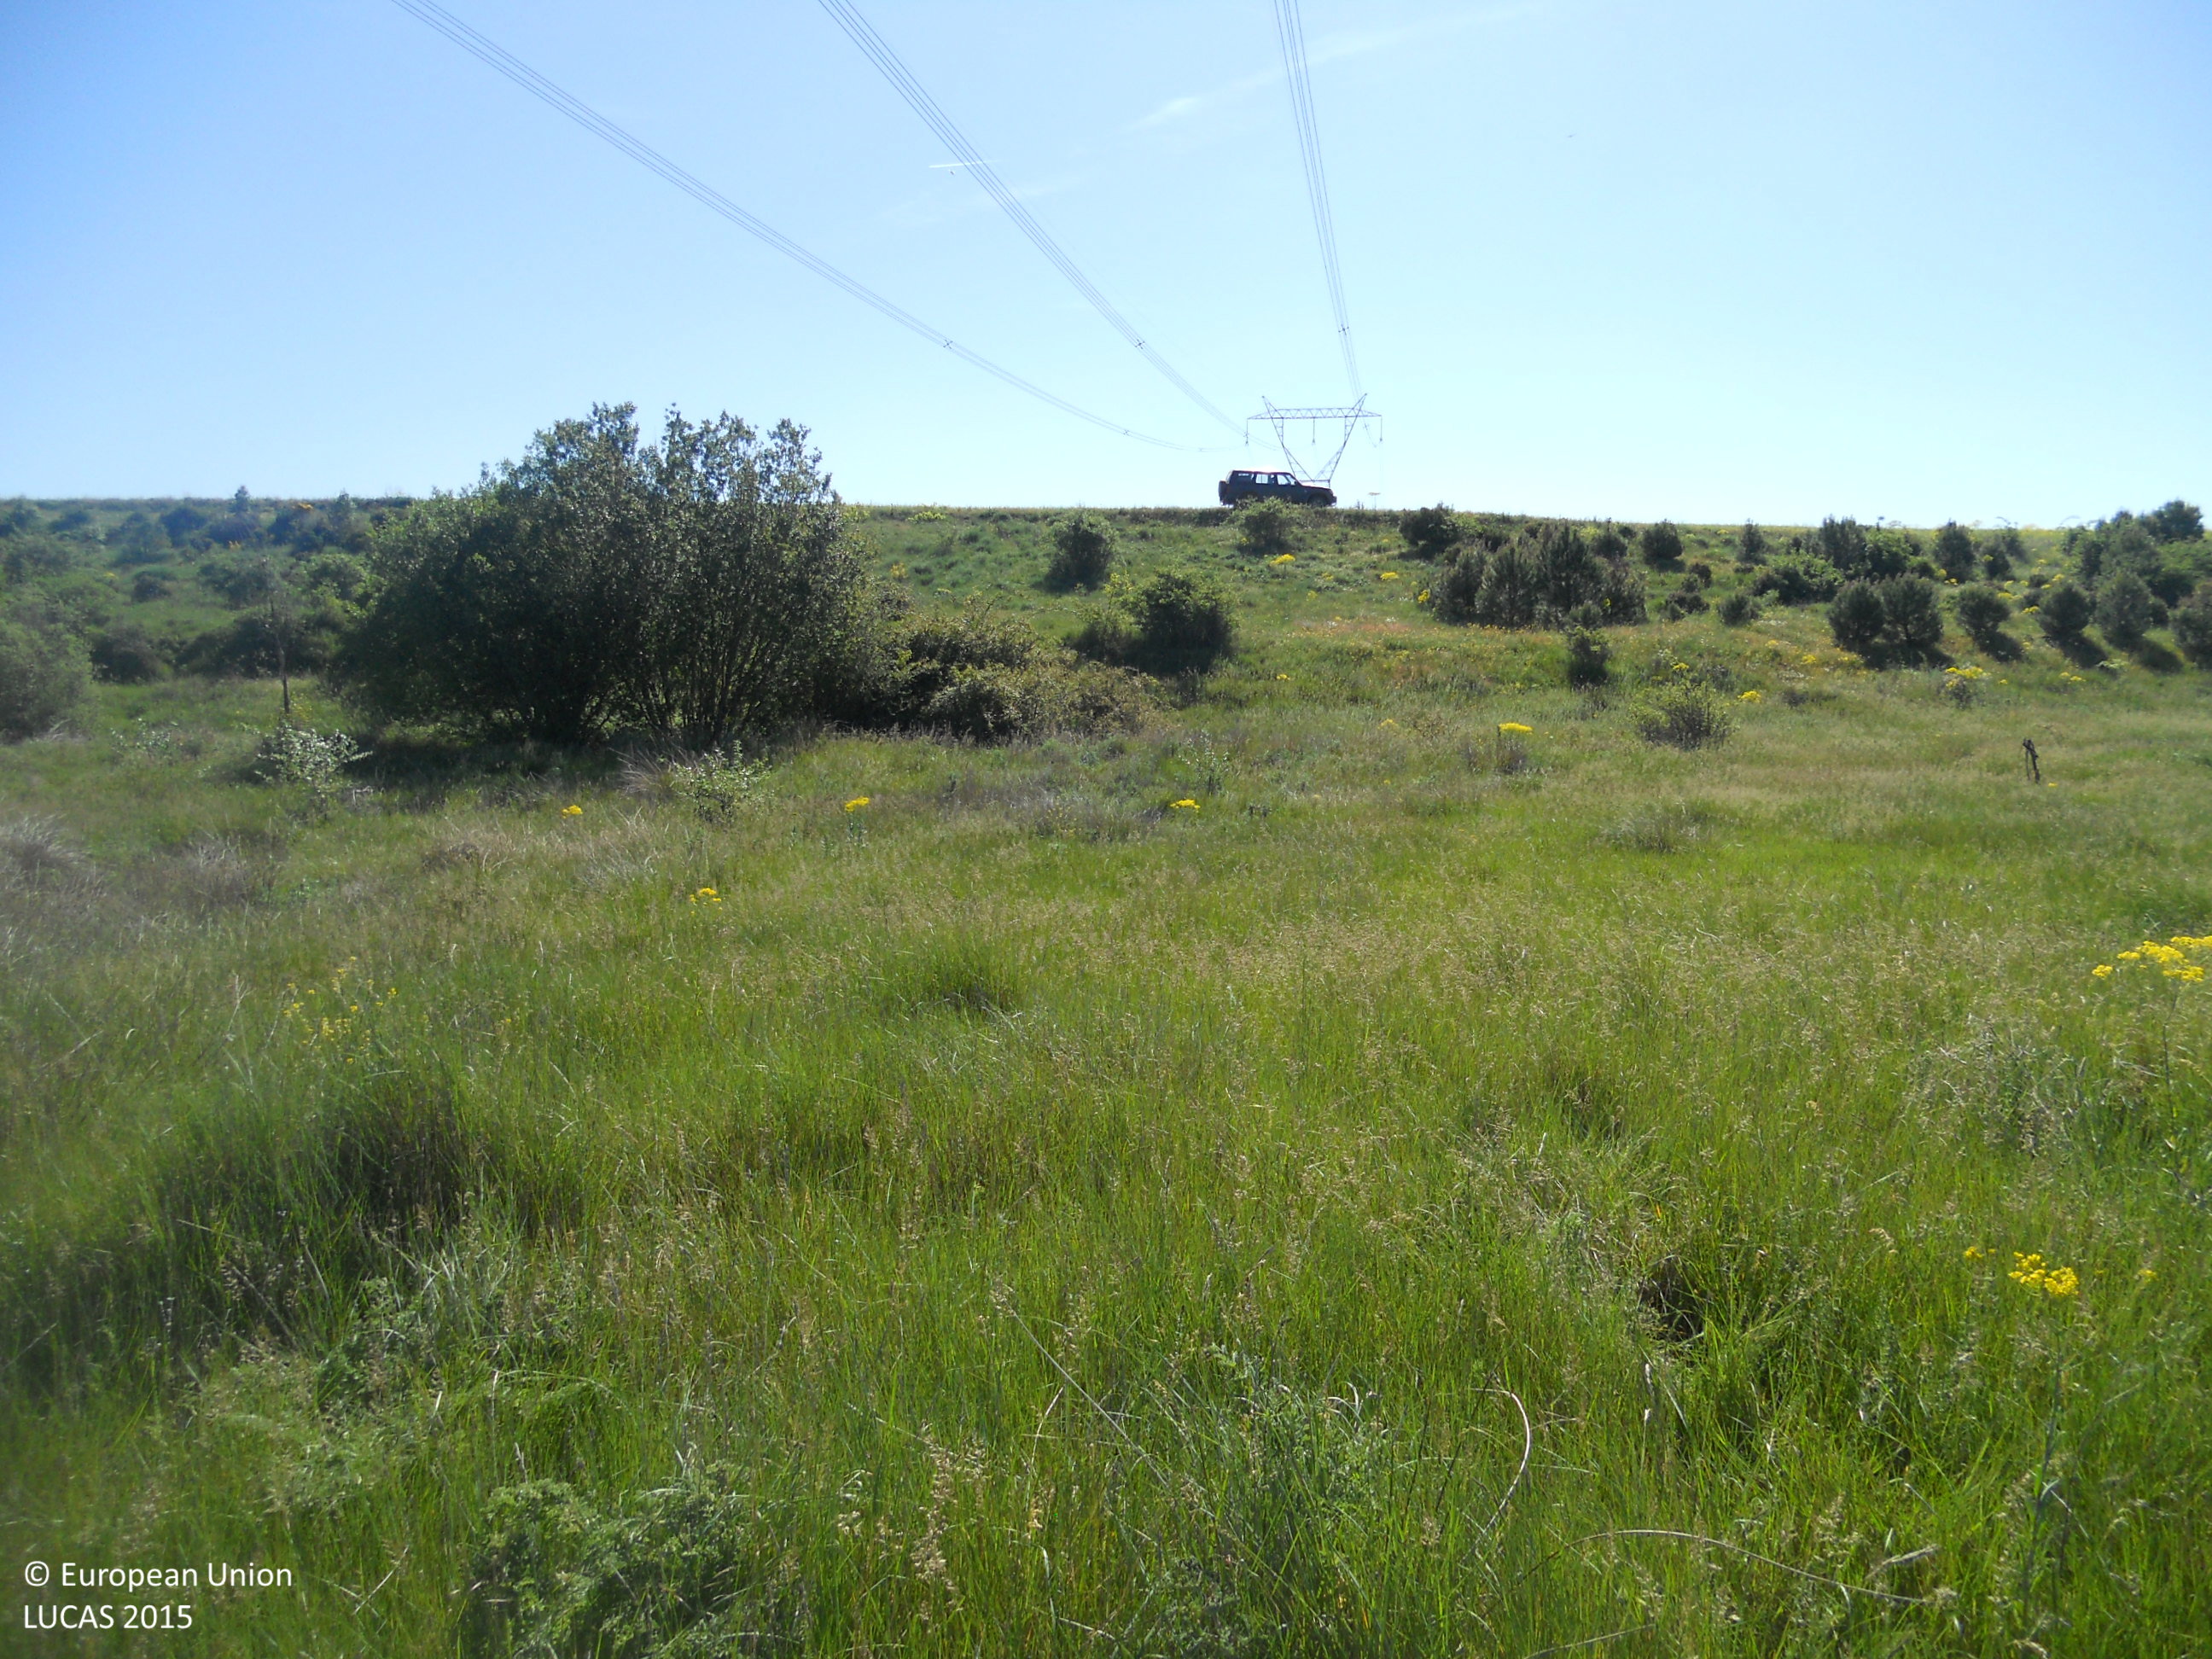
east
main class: Grassland
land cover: Grassland without tree/shrub cover
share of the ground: > 75 %
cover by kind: herbaceous plants 100 %
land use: Semi-natural and natural areas not in use
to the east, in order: Grassland without tree/shrub cover; Electric lines; Grassland without tree/shrub cover; Rivers and streams; Single bushes/trees; Grassland with sparse tree/shrub cover; Spontaneously vegetated surfaces
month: May
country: ES
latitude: 42.4504
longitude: -5.5737
